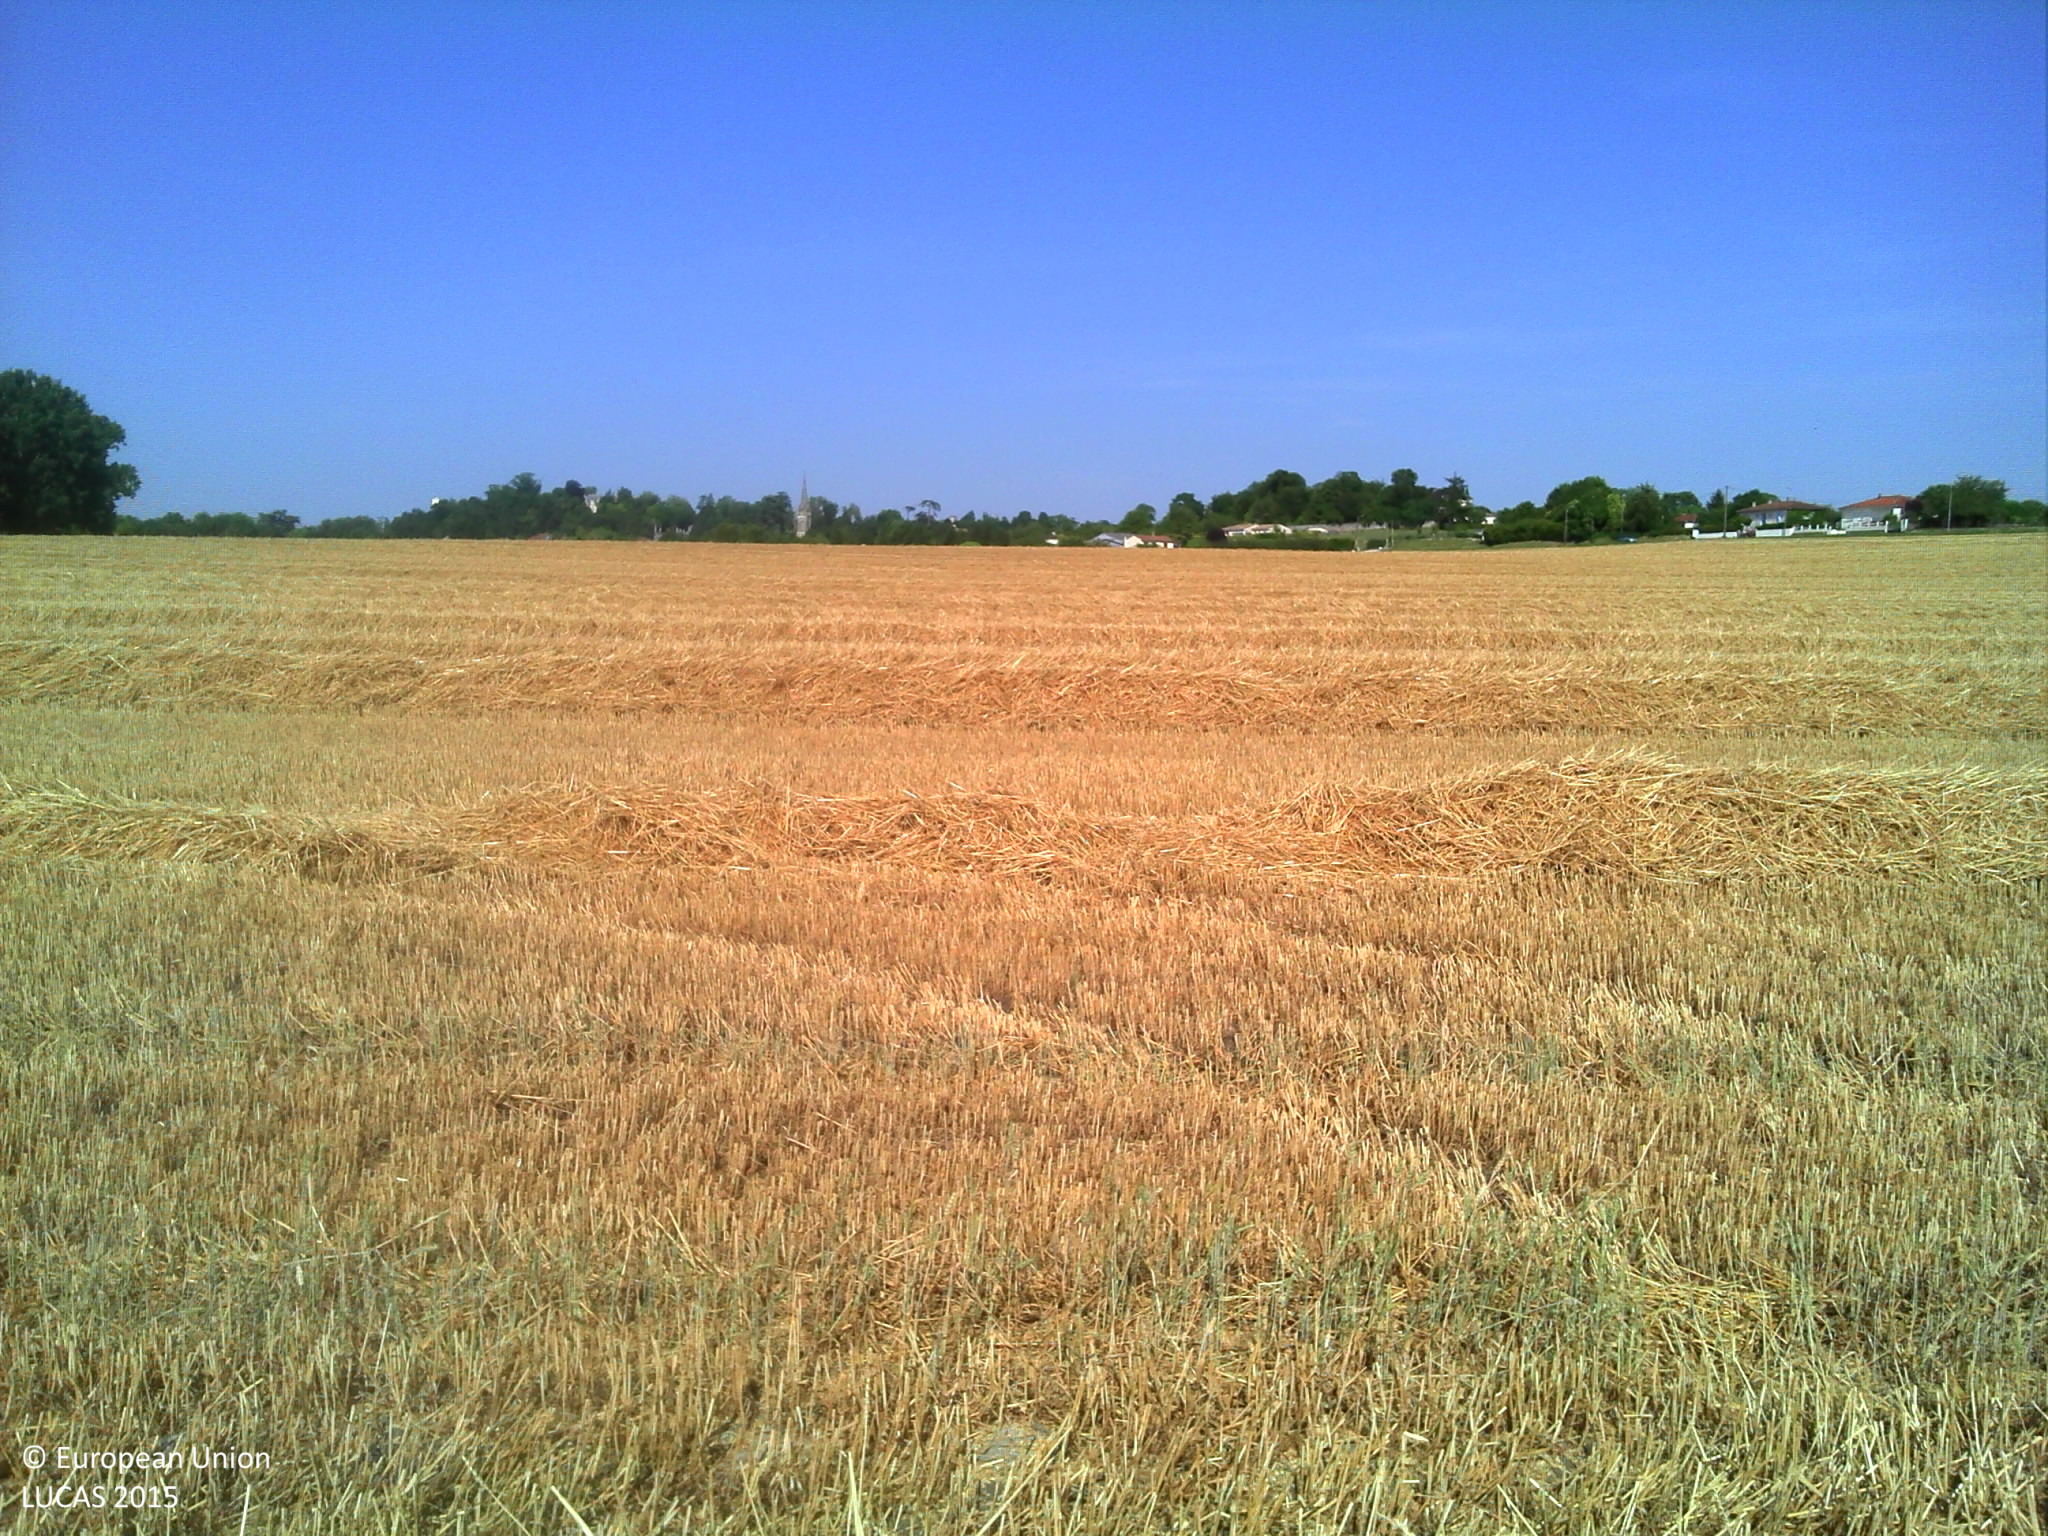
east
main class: Cropland
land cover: Common wheat
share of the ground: > 75 %
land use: Agriculture (excluding fallow land and kitchen gardens)
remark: Harvested field
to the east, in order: Common wheat
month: July
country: FR
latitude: 45.3708
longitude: -0.5812
